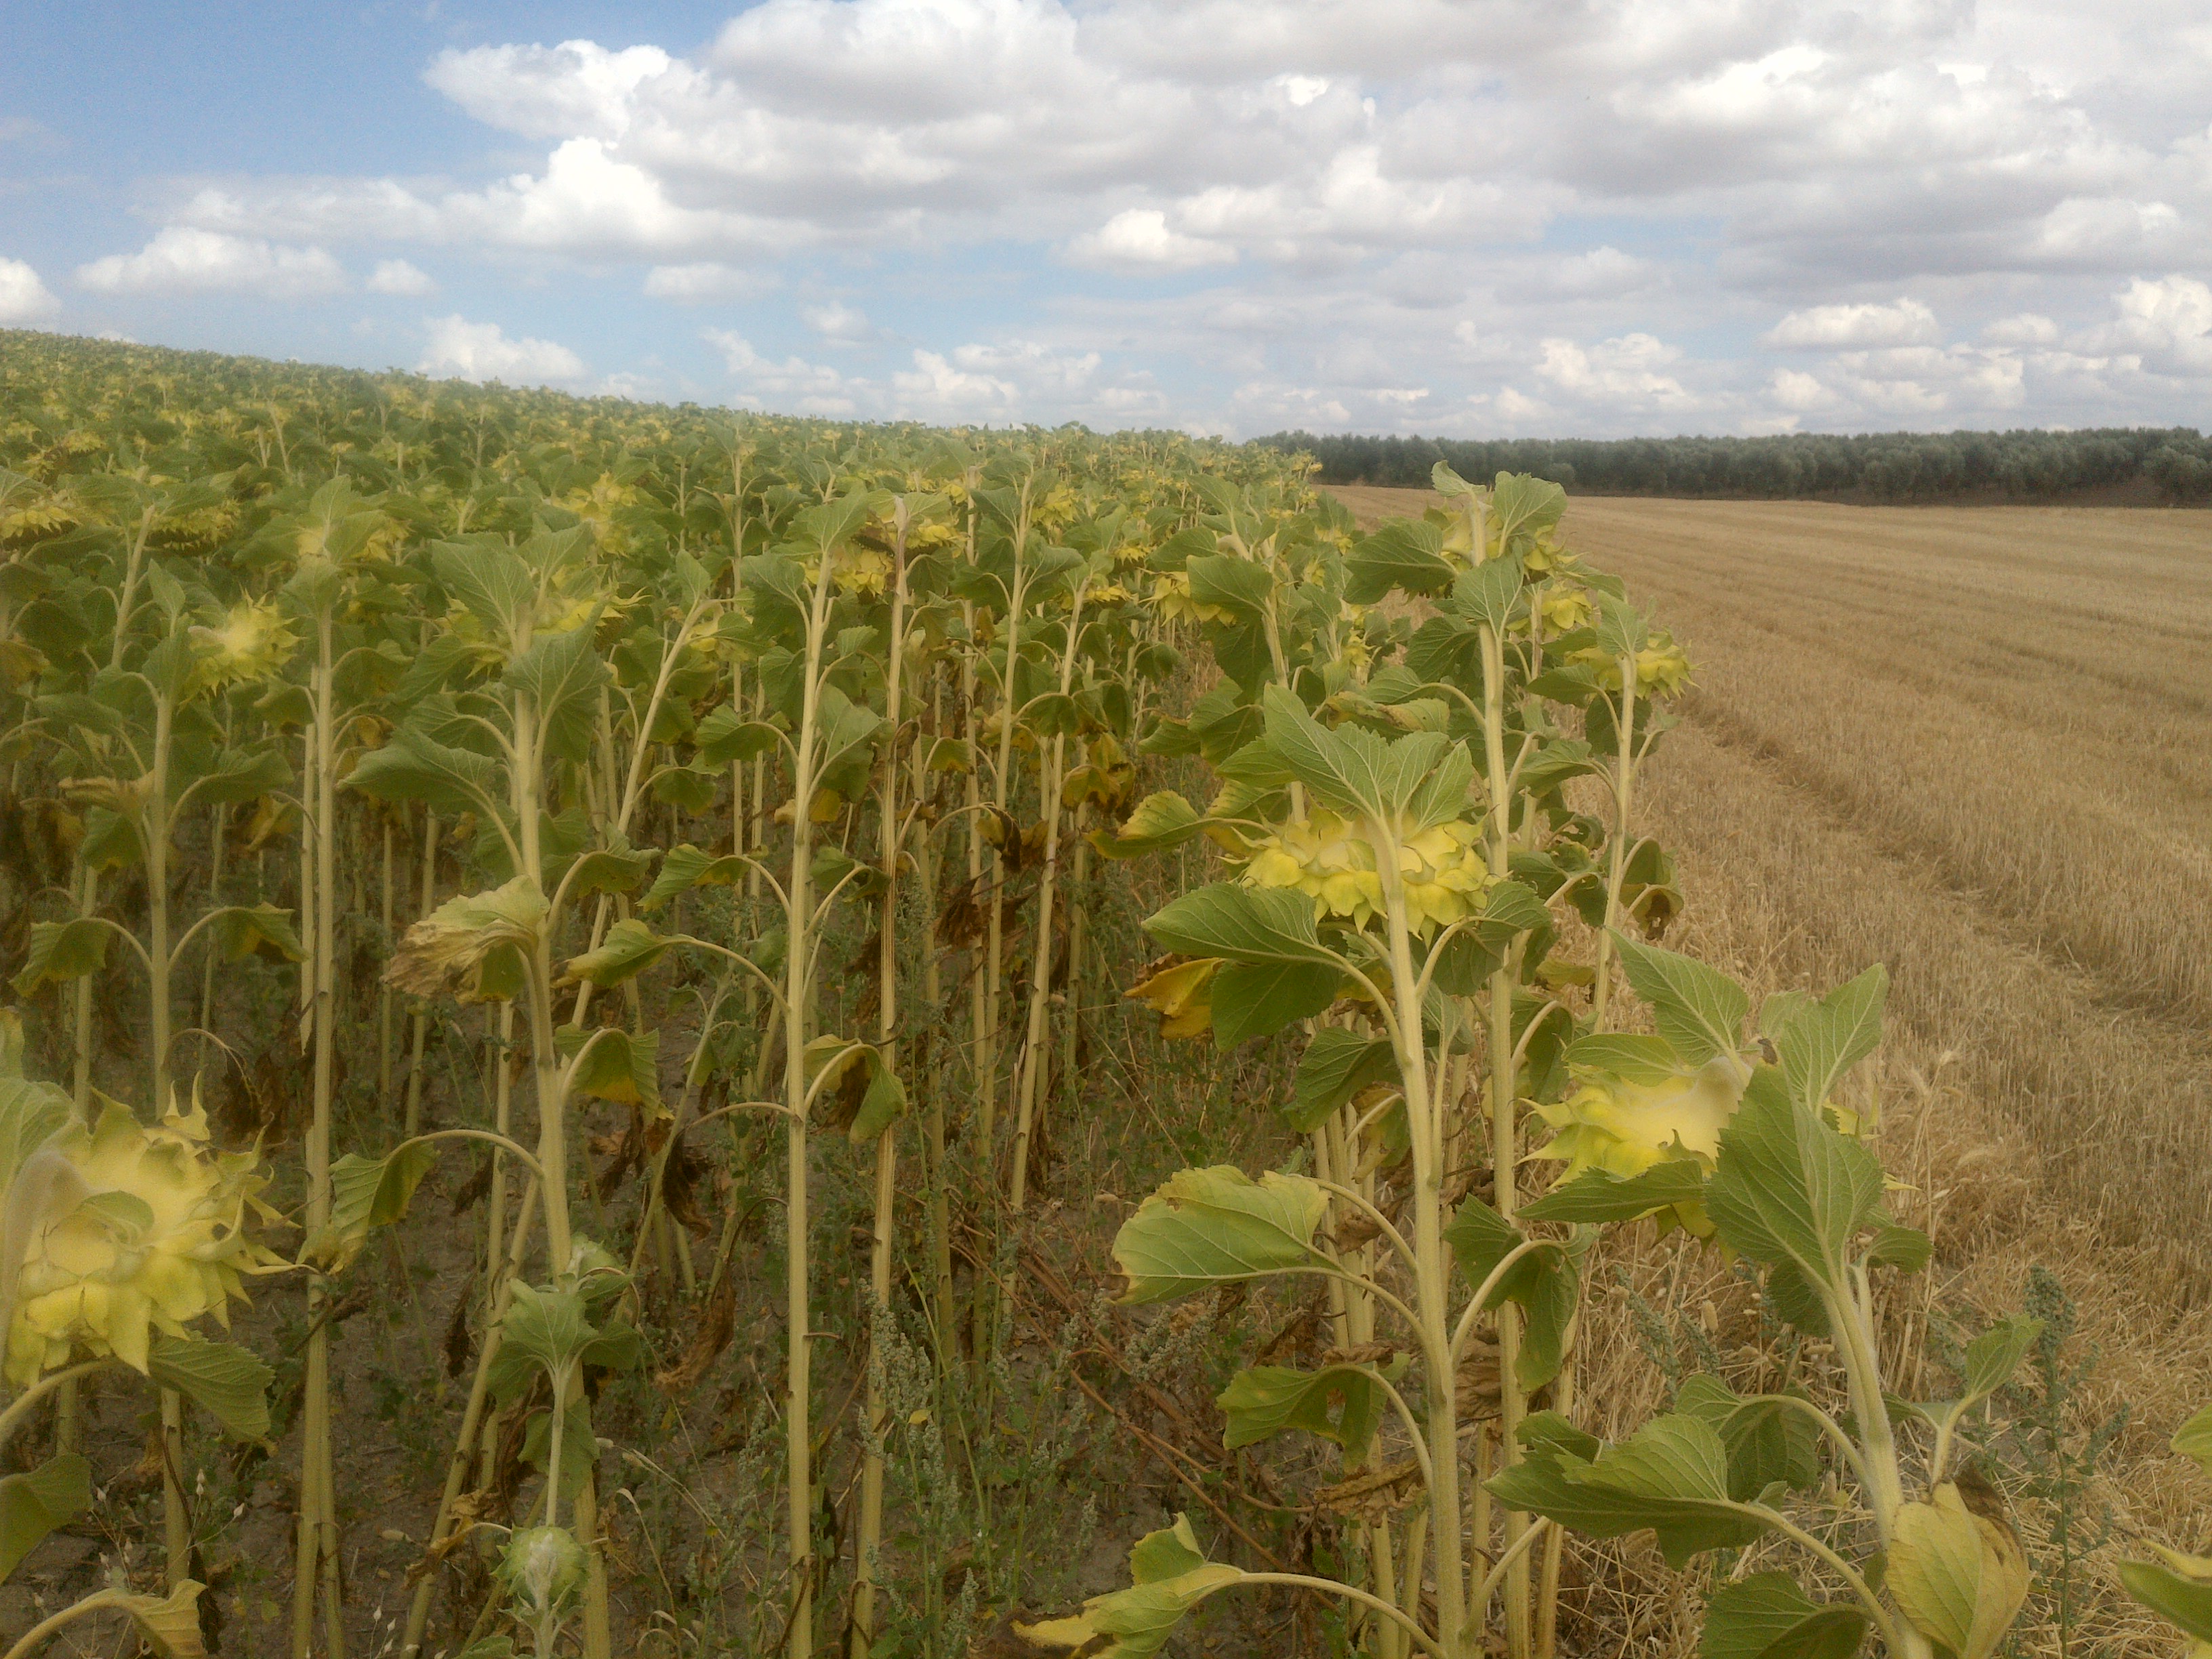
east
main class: Cropland
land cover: Sunflower
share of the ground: > 75 %
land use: Agriculture (excluding fallow land and kitchen gardens)
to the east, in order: Sunflower; Grass margins; Olive groves
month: June
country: ES
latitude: 37.8009
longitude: -4.5358
